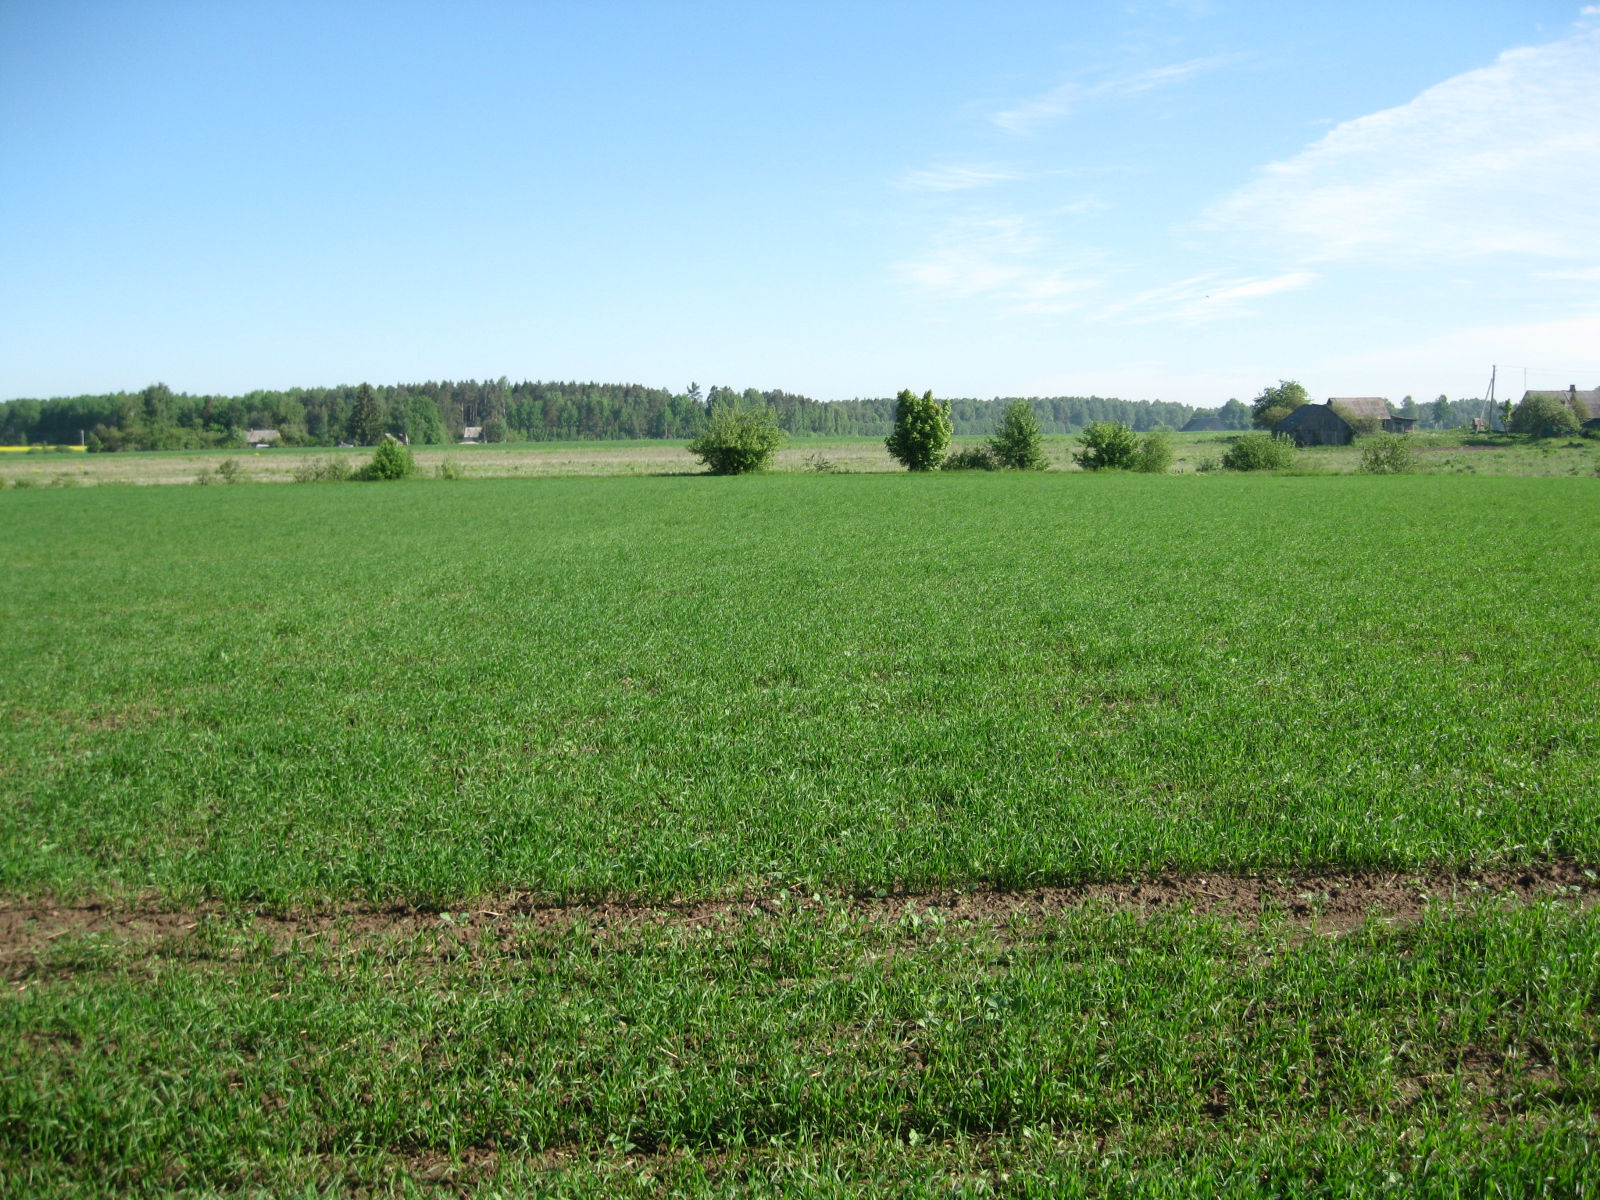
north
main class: Cropland
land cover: Common wheat
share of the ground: 50 - 75 %
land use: Agriculture (excluding fallow land and kitchen gardens)
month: May
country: LT
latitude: 55.8499
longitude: 24.3593
